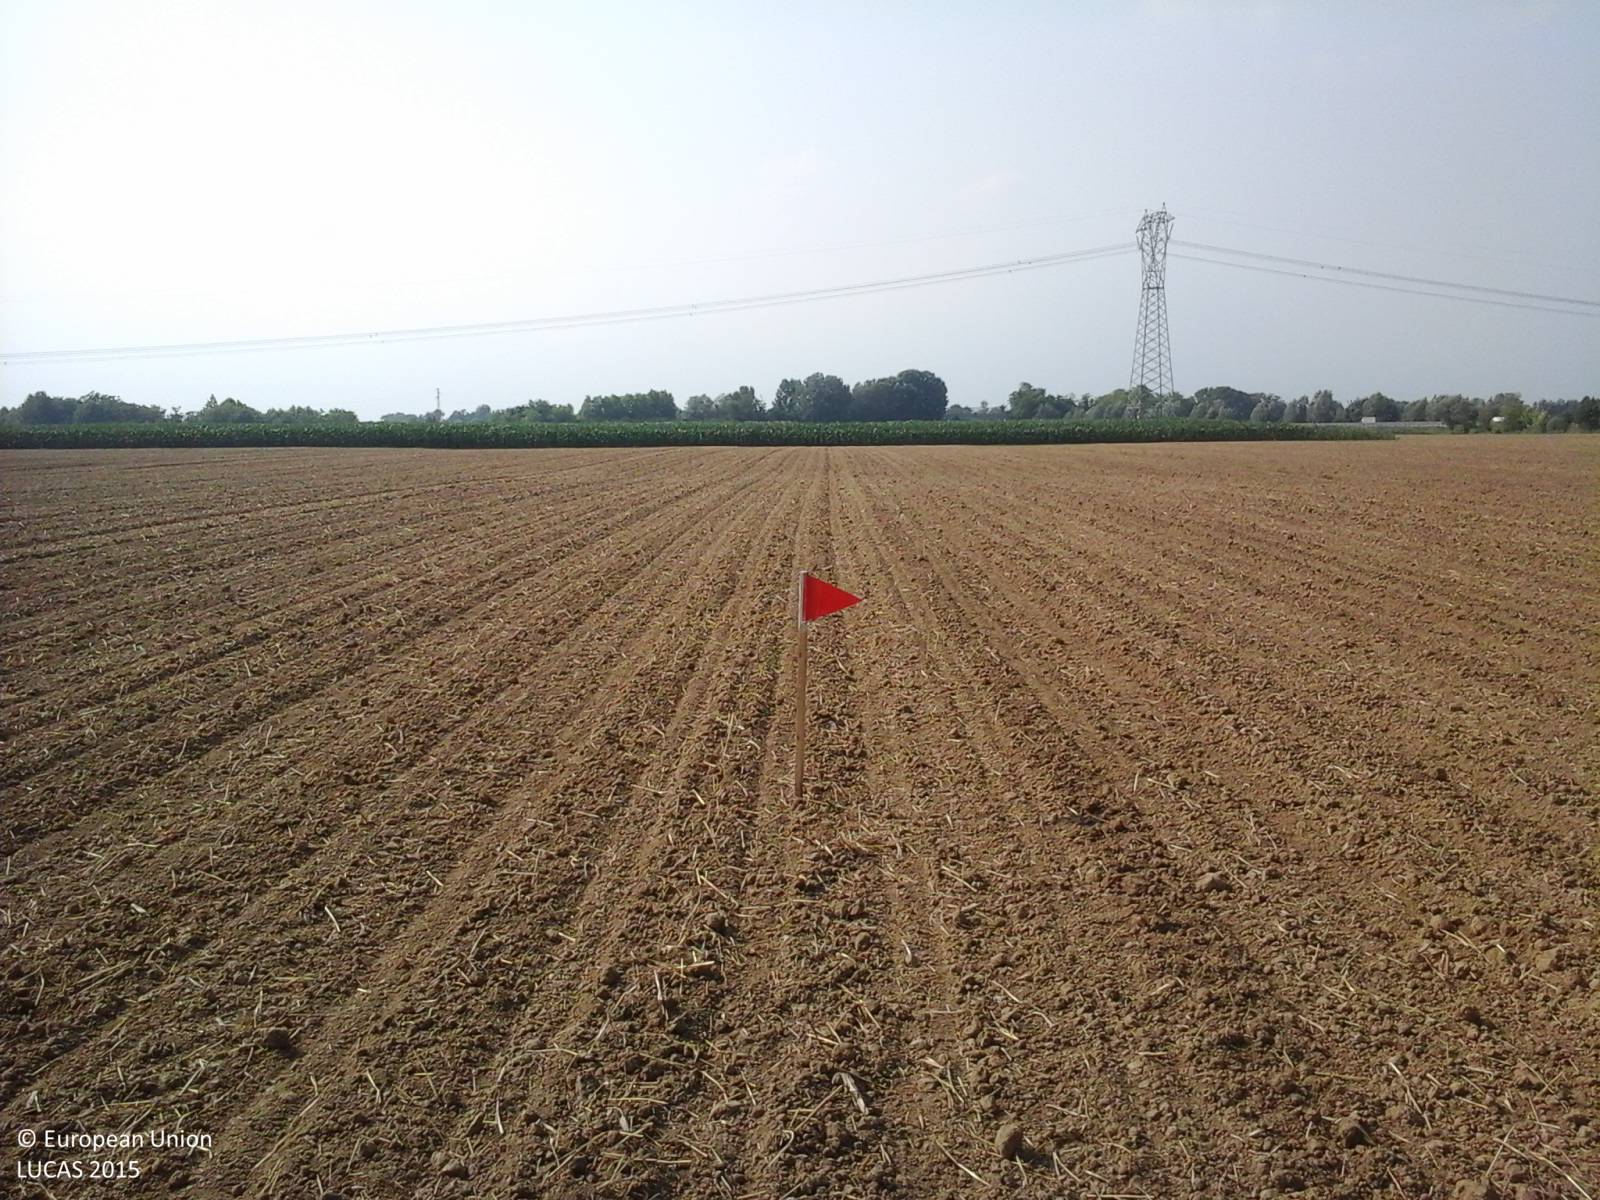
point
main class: Cropland
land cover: Common wheat
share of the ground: < 10 %
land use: Agriculture (excluding fallow land and kitchen gardens)
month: July
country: IT
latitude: 45.9208
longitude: 12.6914
